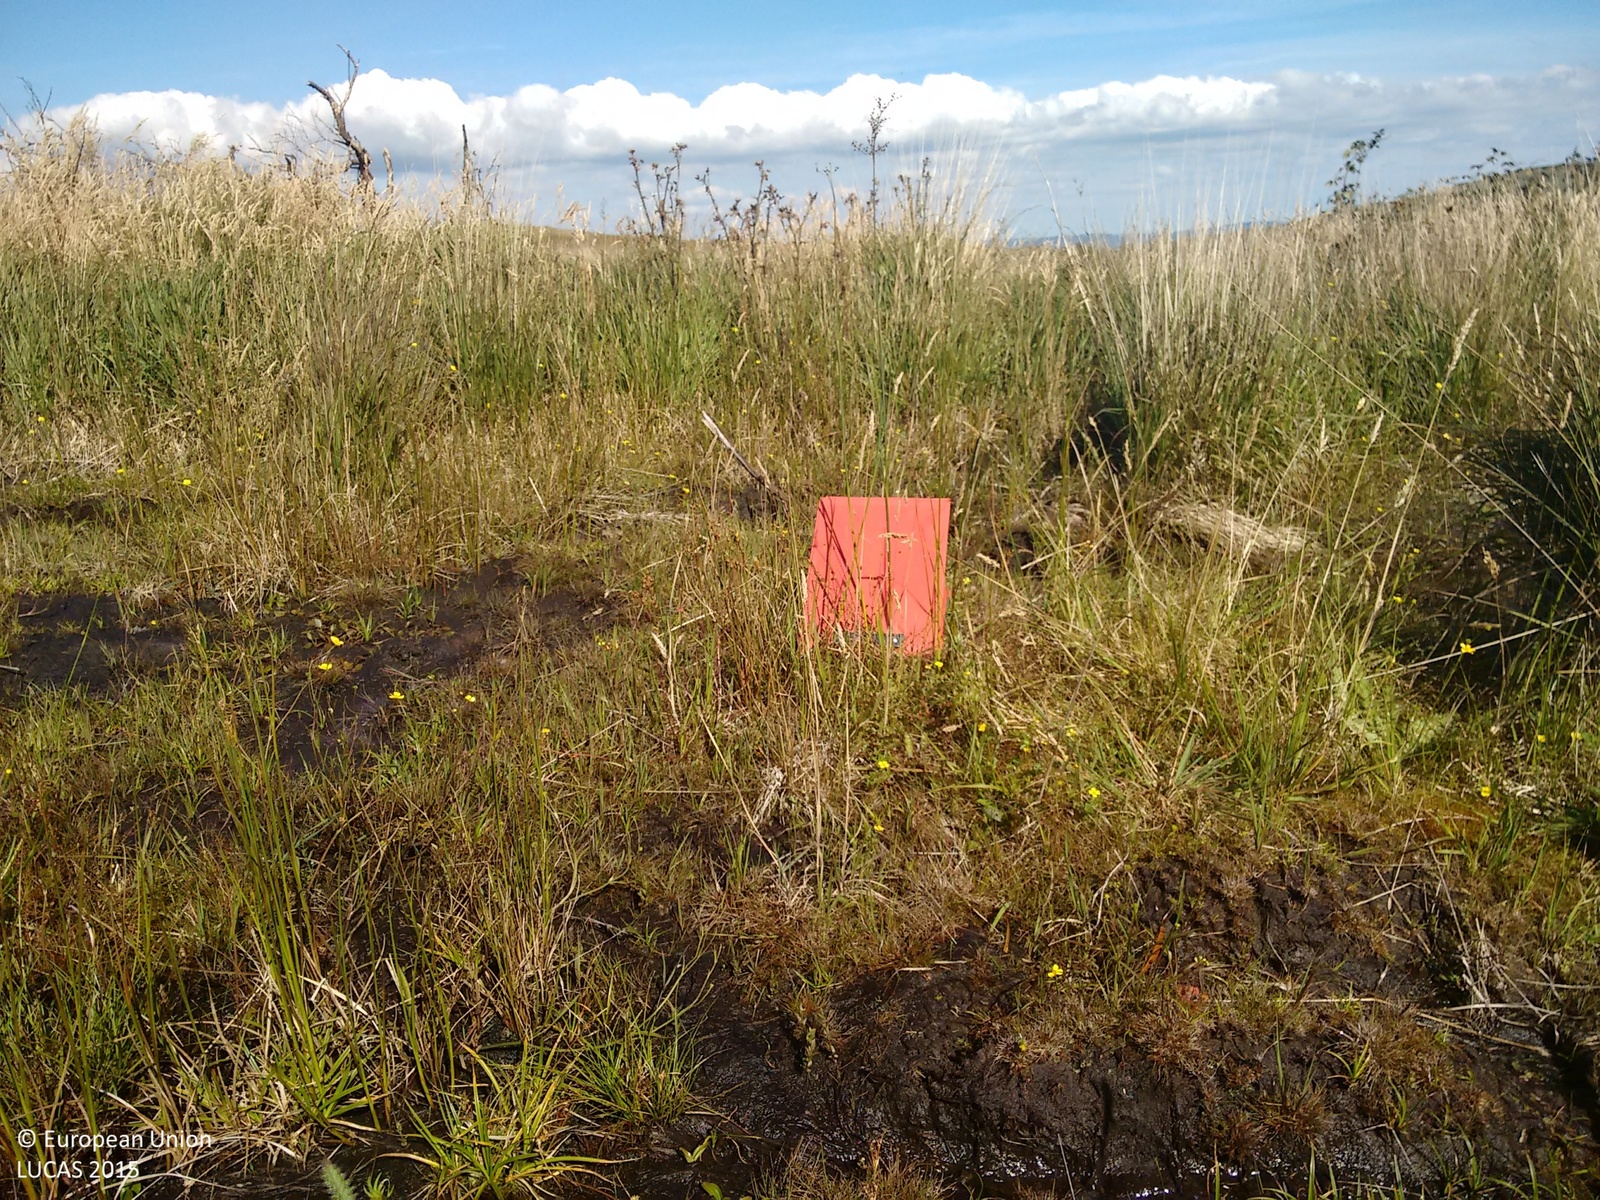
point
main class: Grassland
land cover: Spontaneously vegetated surfaces
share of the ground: > 75 %
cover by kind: herbaceous plants 70 %, unconsolidated bare surface 30 %
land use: Semi-natural and natural areas not in use
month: August
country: IE
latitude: 51.6199
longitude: -9.4251
